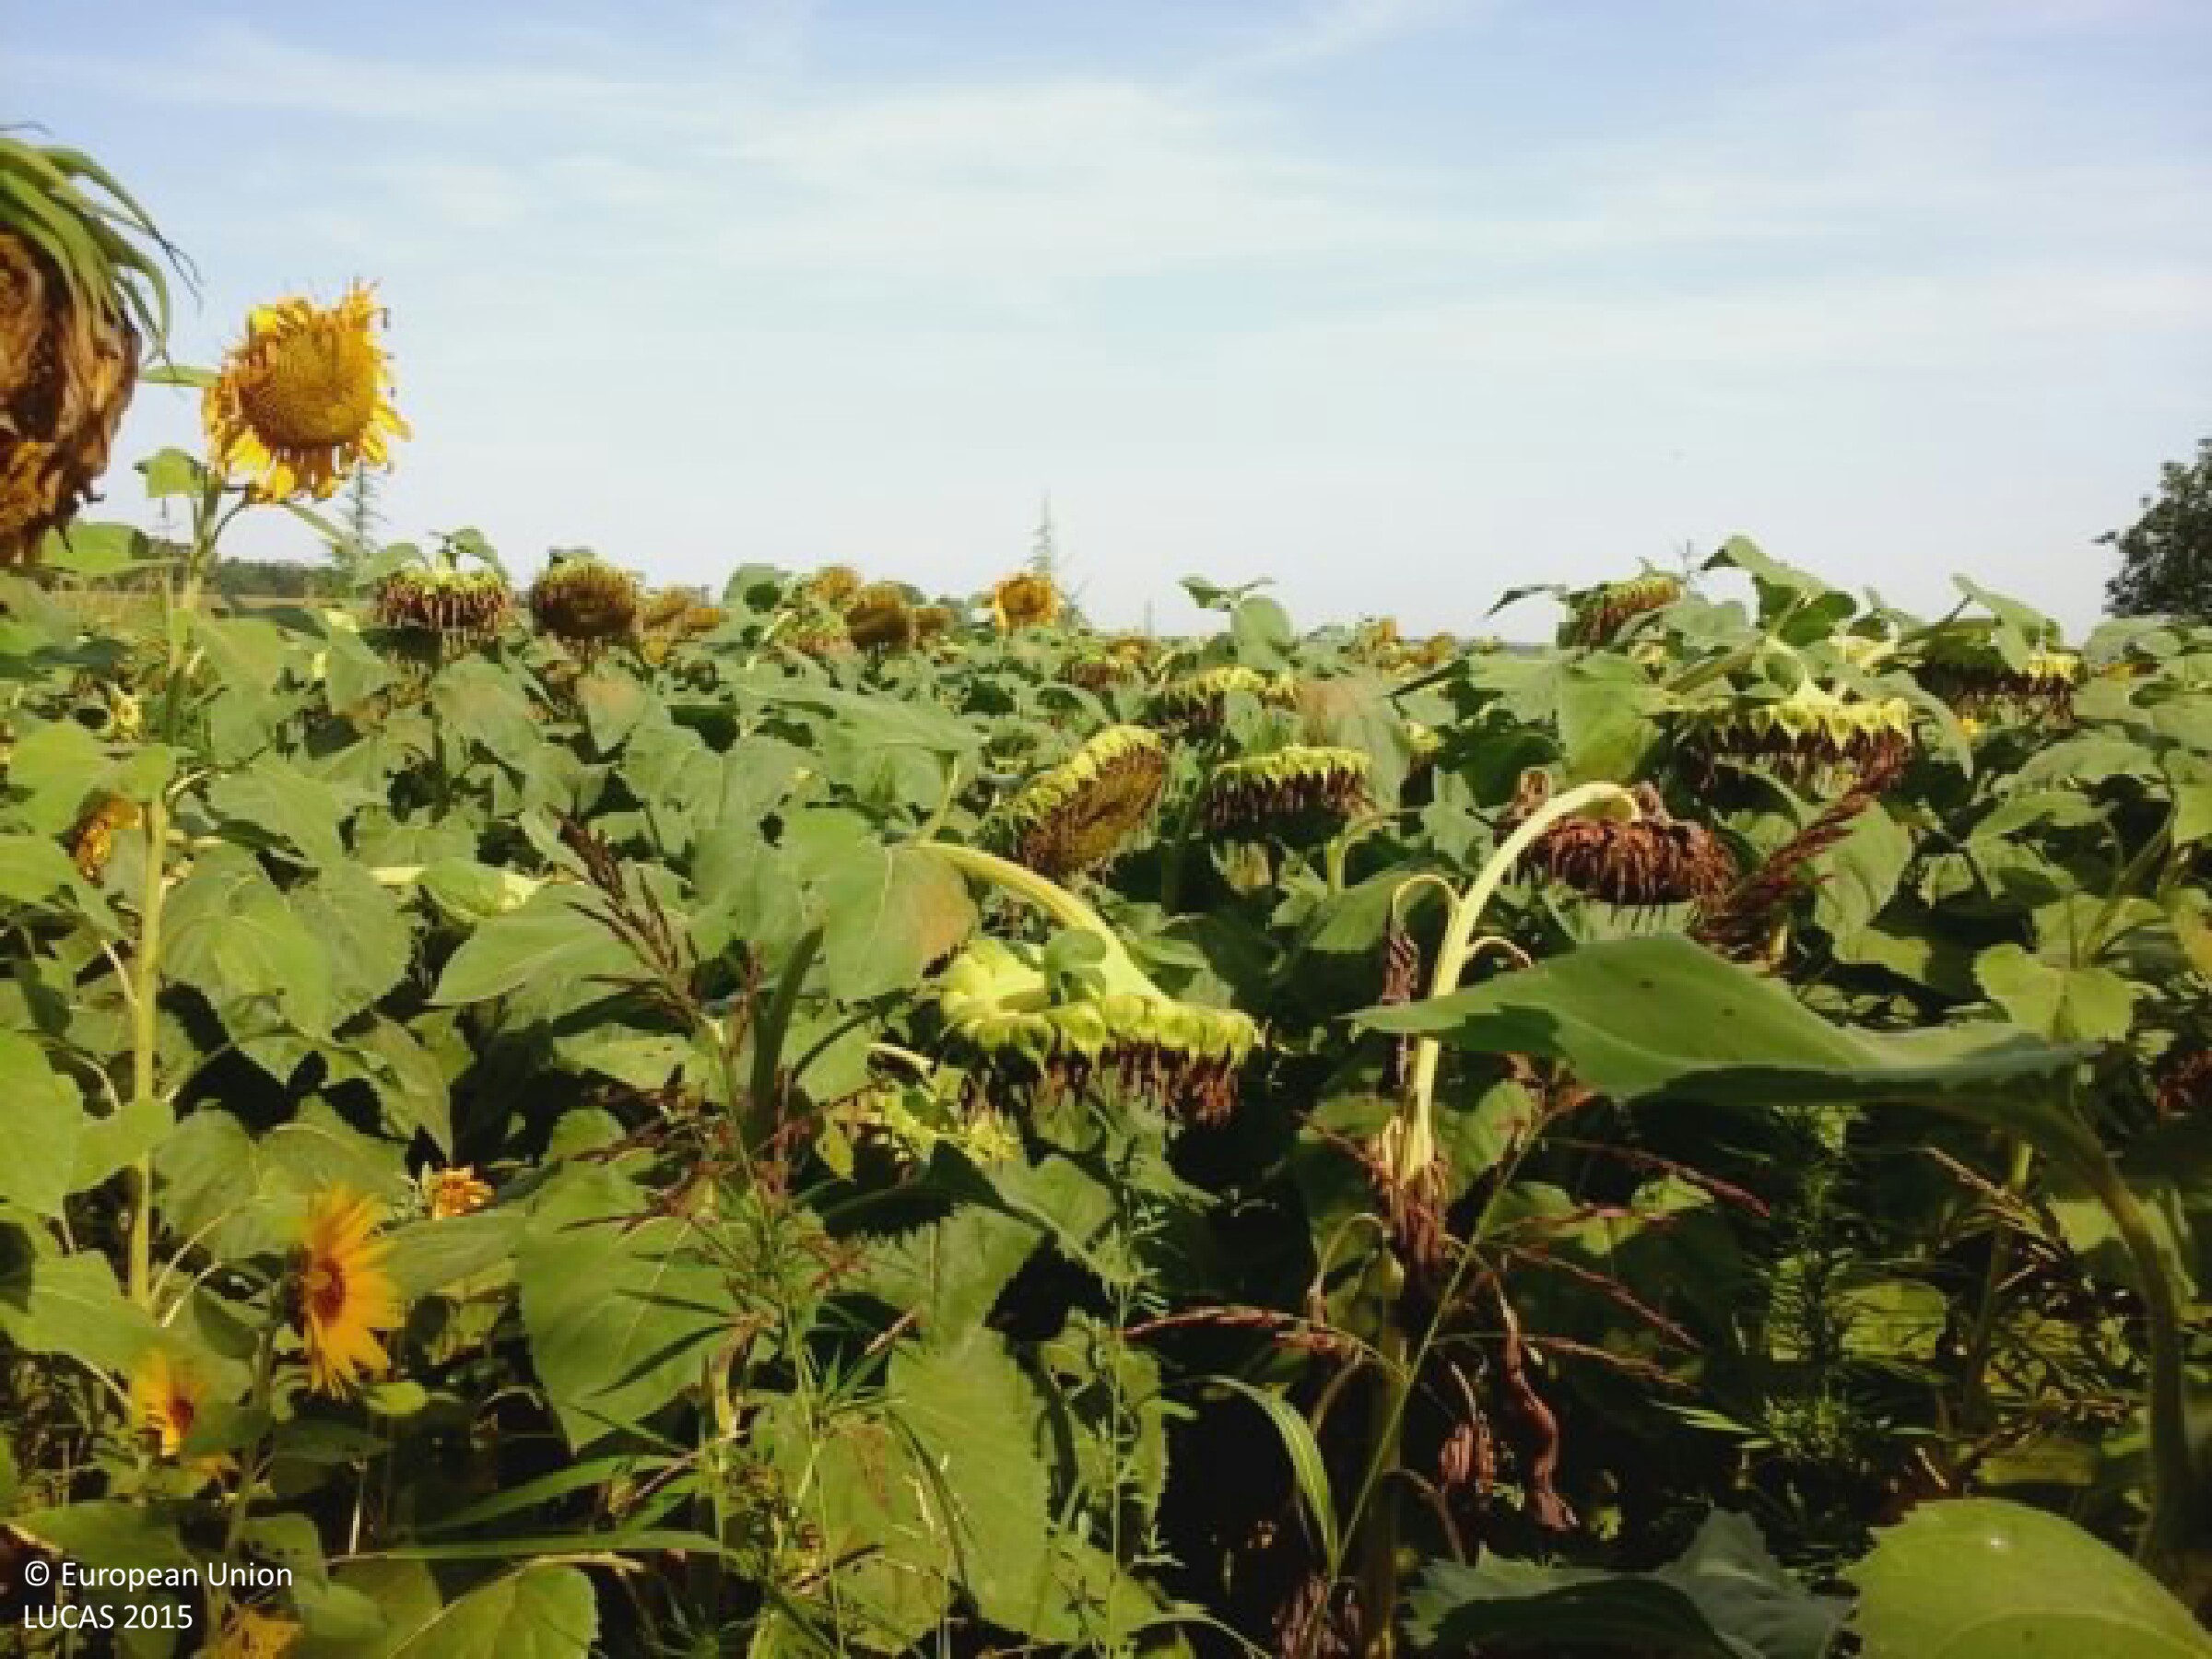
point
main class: Cropland
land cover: Sunflower
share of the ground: > 75 %
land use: Agriculture (excluding fallow land and kitchen gardens)
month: August
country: HU
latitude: 46.6353
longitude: 18.1730
